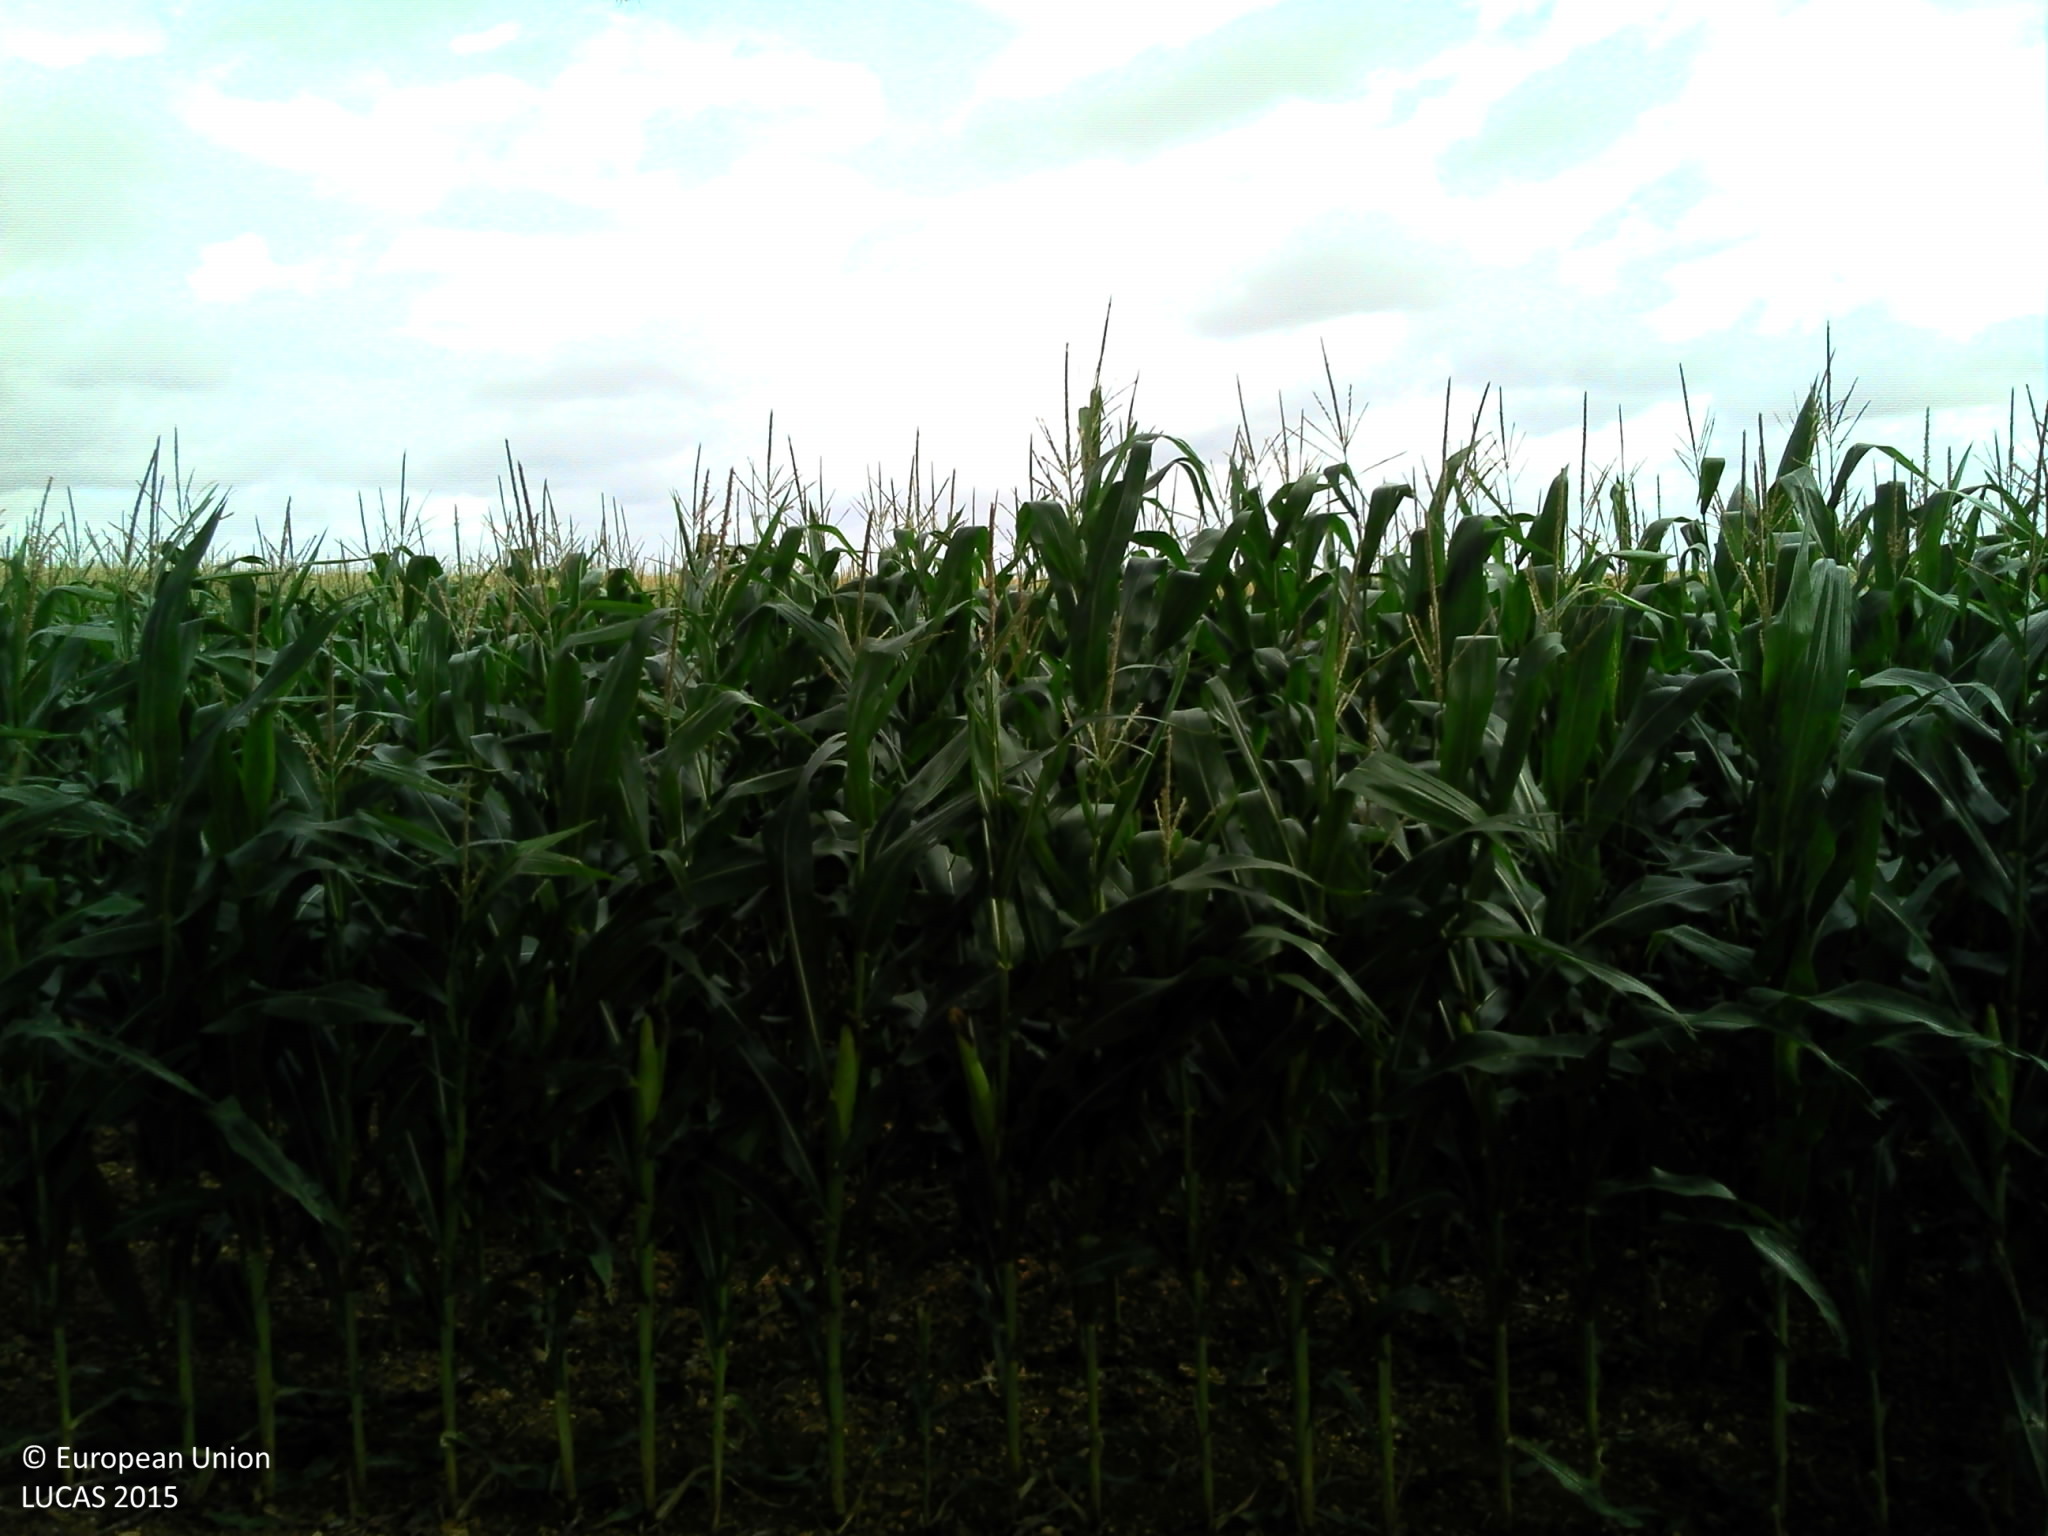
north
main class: Cropland
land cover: Maize
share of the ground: > 75 %
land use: Agriculture (excluding fallow land and kitchen gardens)
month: July
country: FR
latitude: 46.3424
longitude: 0.2758
